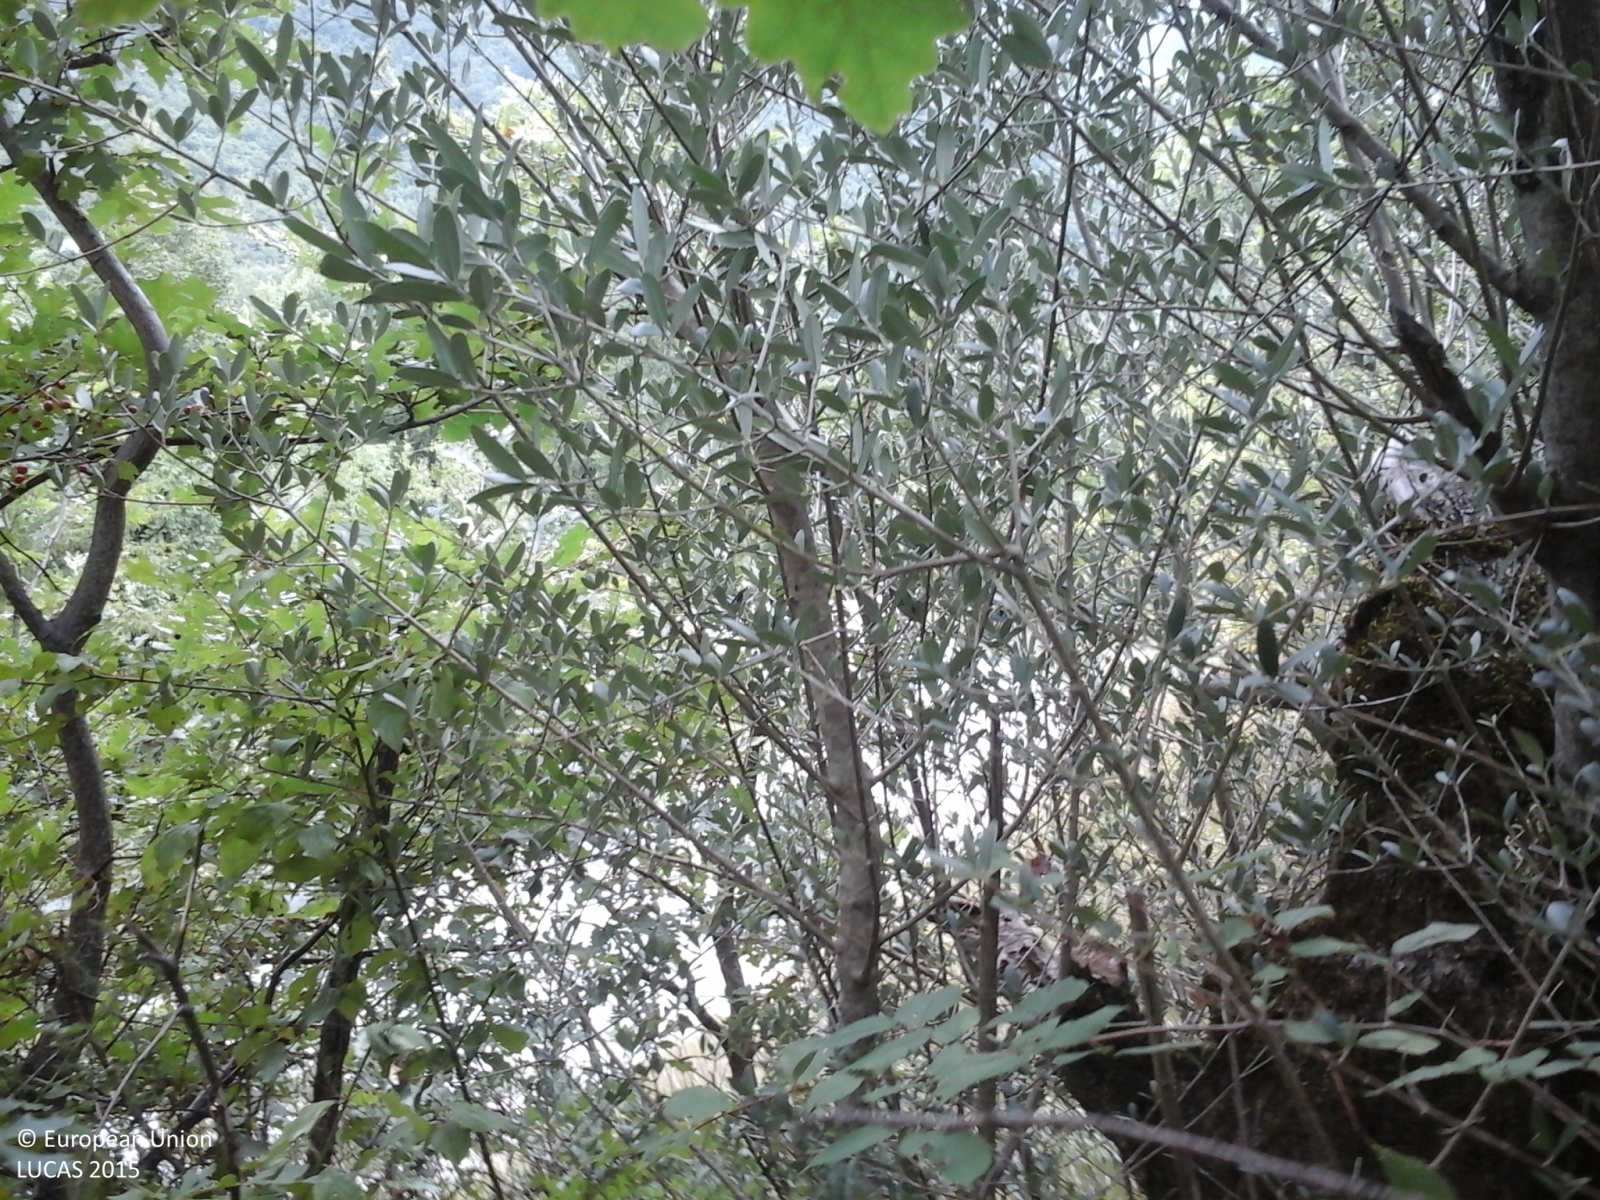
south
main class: Woodland
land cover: Broadleaved woodland
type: thermophilous deciduous forest
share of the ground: 50 - 75 %
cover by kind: broadleaved forest trees 95 %, coniferous forest trees 5 %
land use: Forestry
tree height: > 5 m
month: August
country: IT
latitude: 43.4040
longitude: 13.0174
